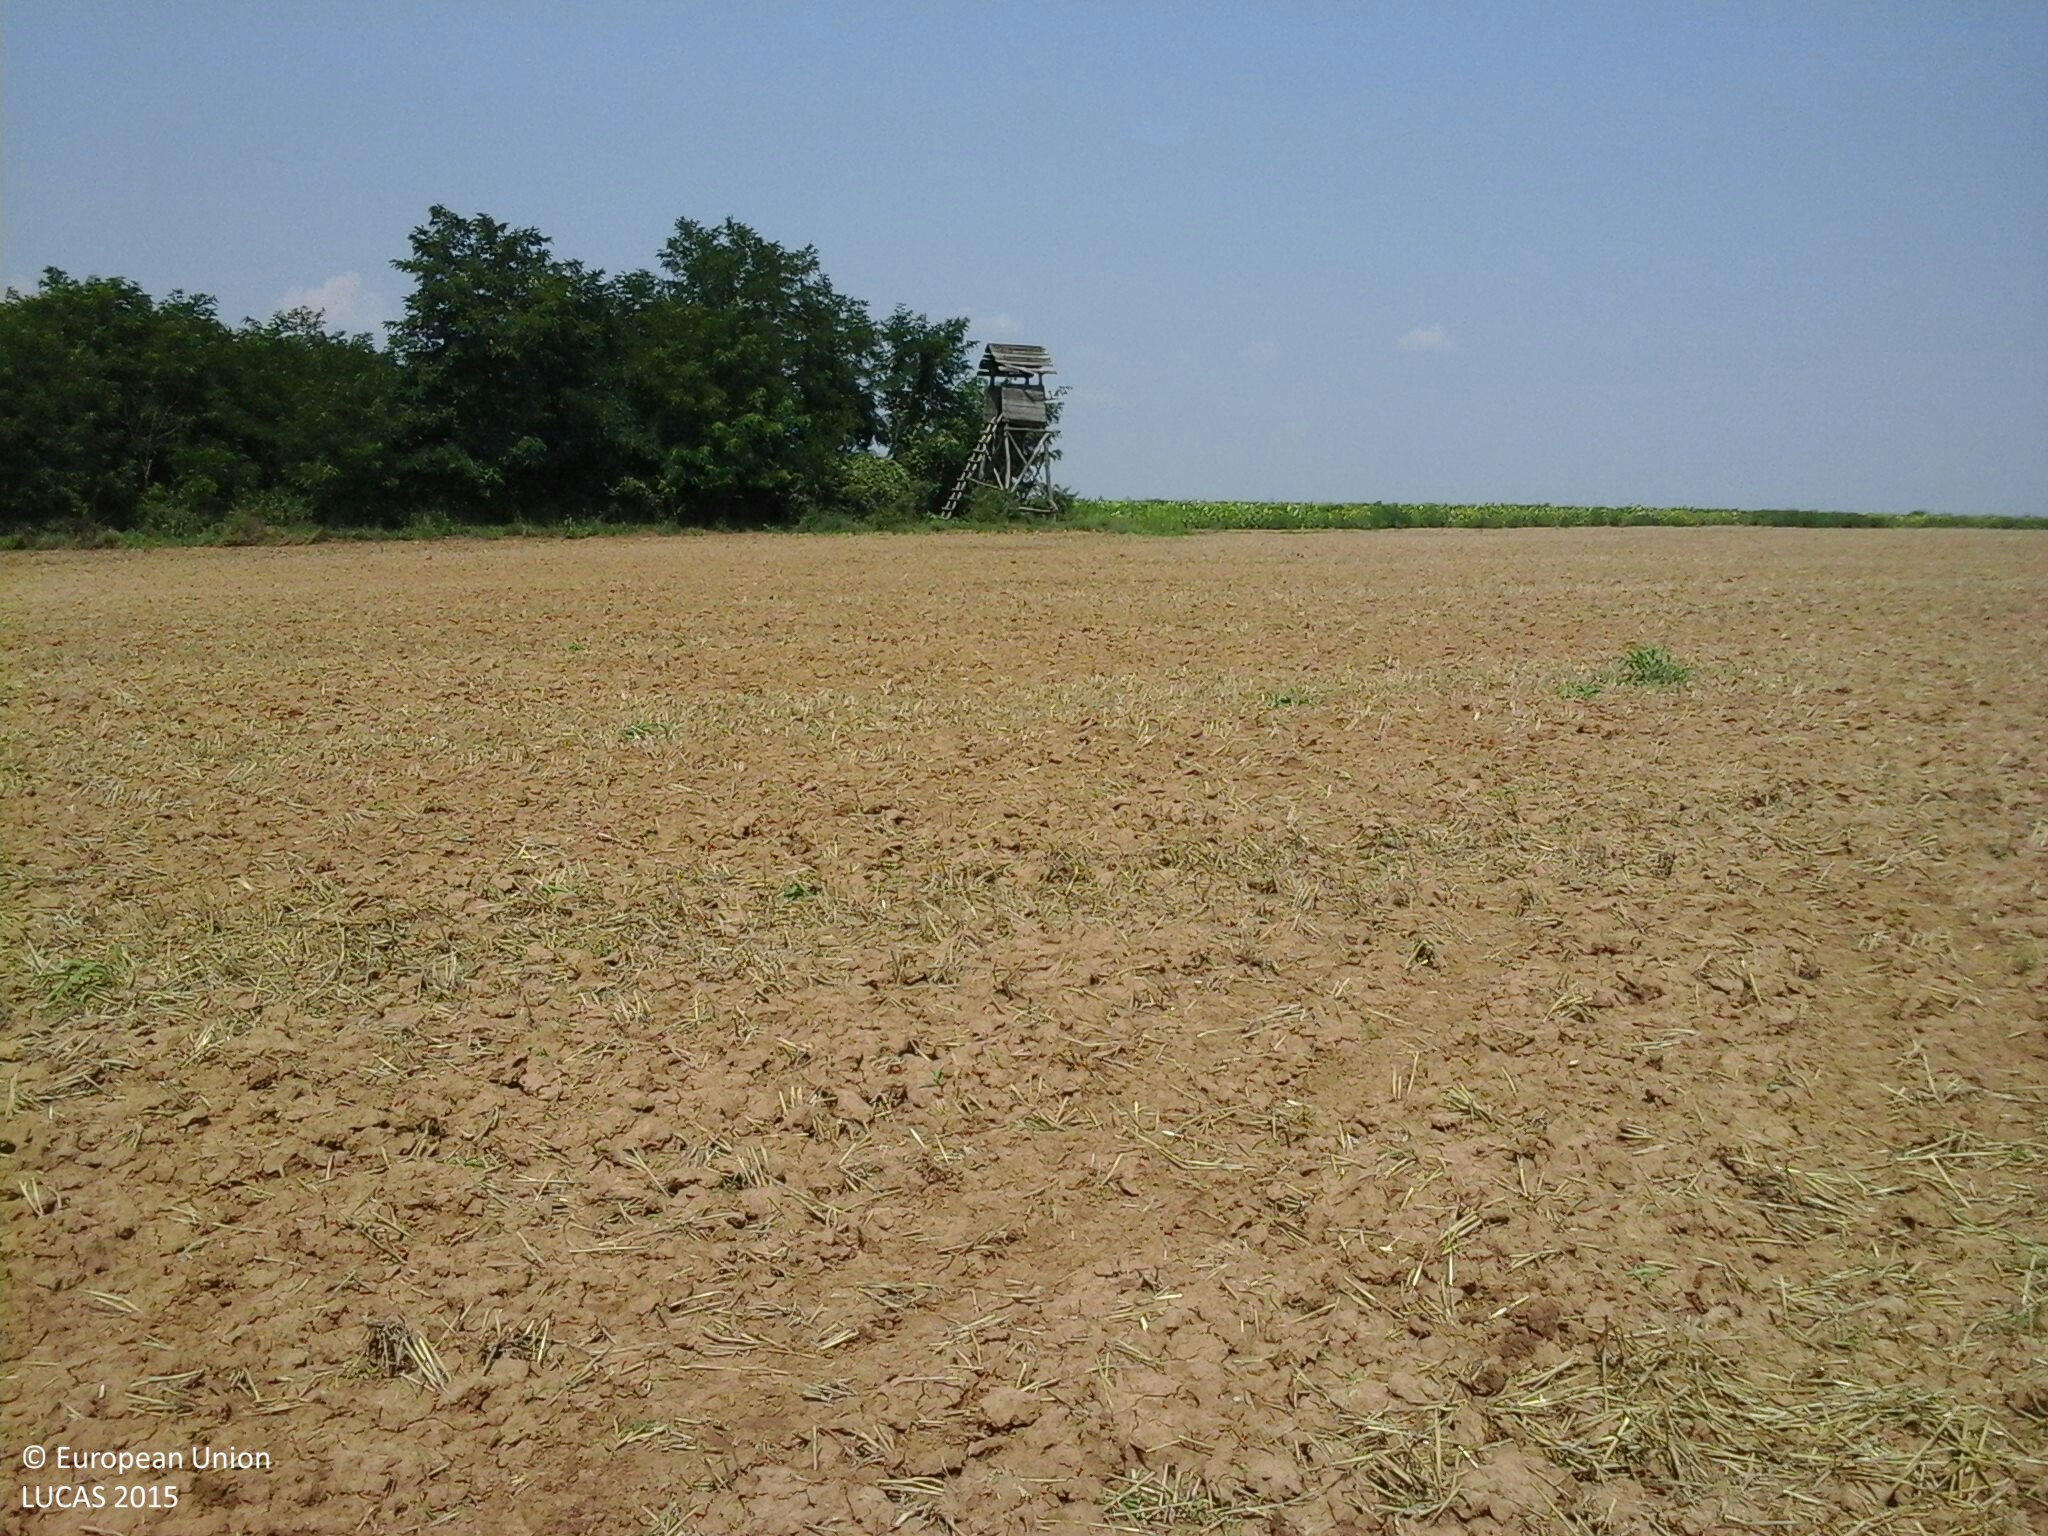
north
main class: Cropland
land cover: Common wheat
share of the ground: < 10 %
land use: Agriculture (excluding fallow land and kitchen gardens)
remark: Harvested field
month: August
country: HU
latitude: 45.9873
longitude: 18.3600
